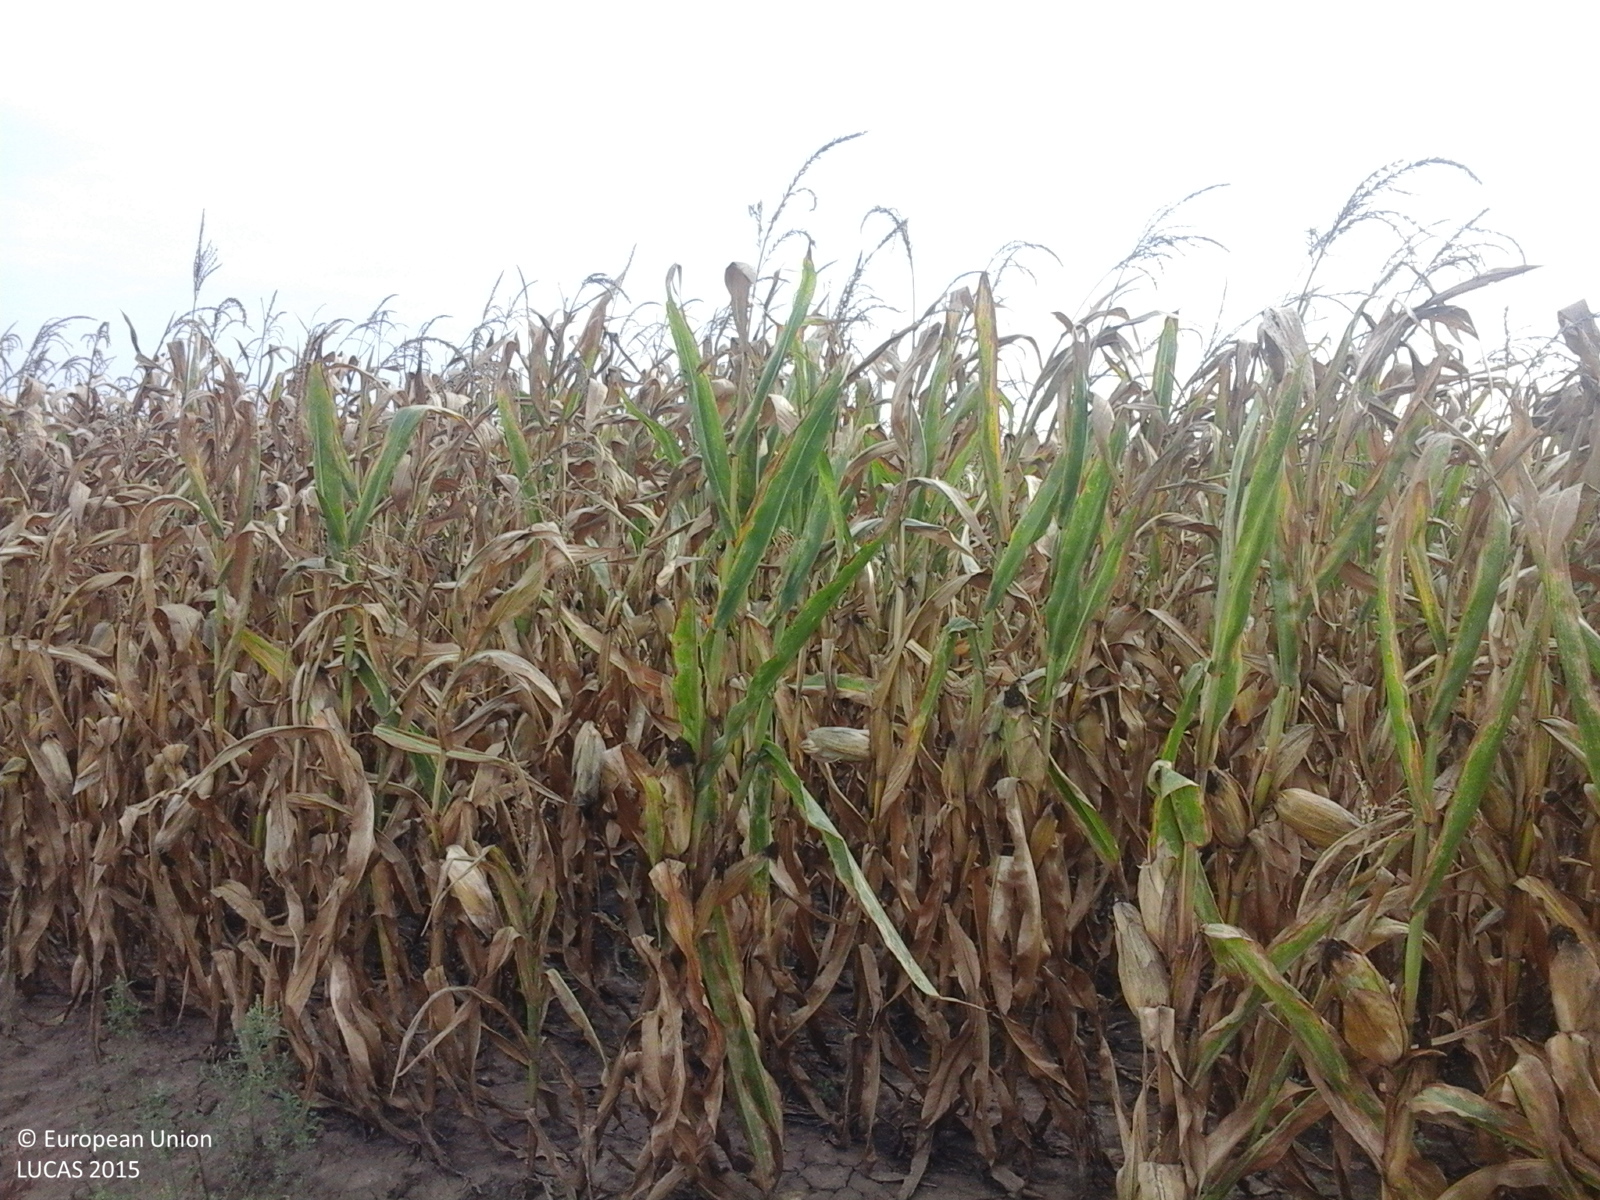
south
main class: Cropland
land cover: Maize
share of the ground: > 75 %
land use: Agriculture (excluding fallow land and kitchen gardens)
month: August
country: RO
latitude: 46.3023
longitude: 21.2382
